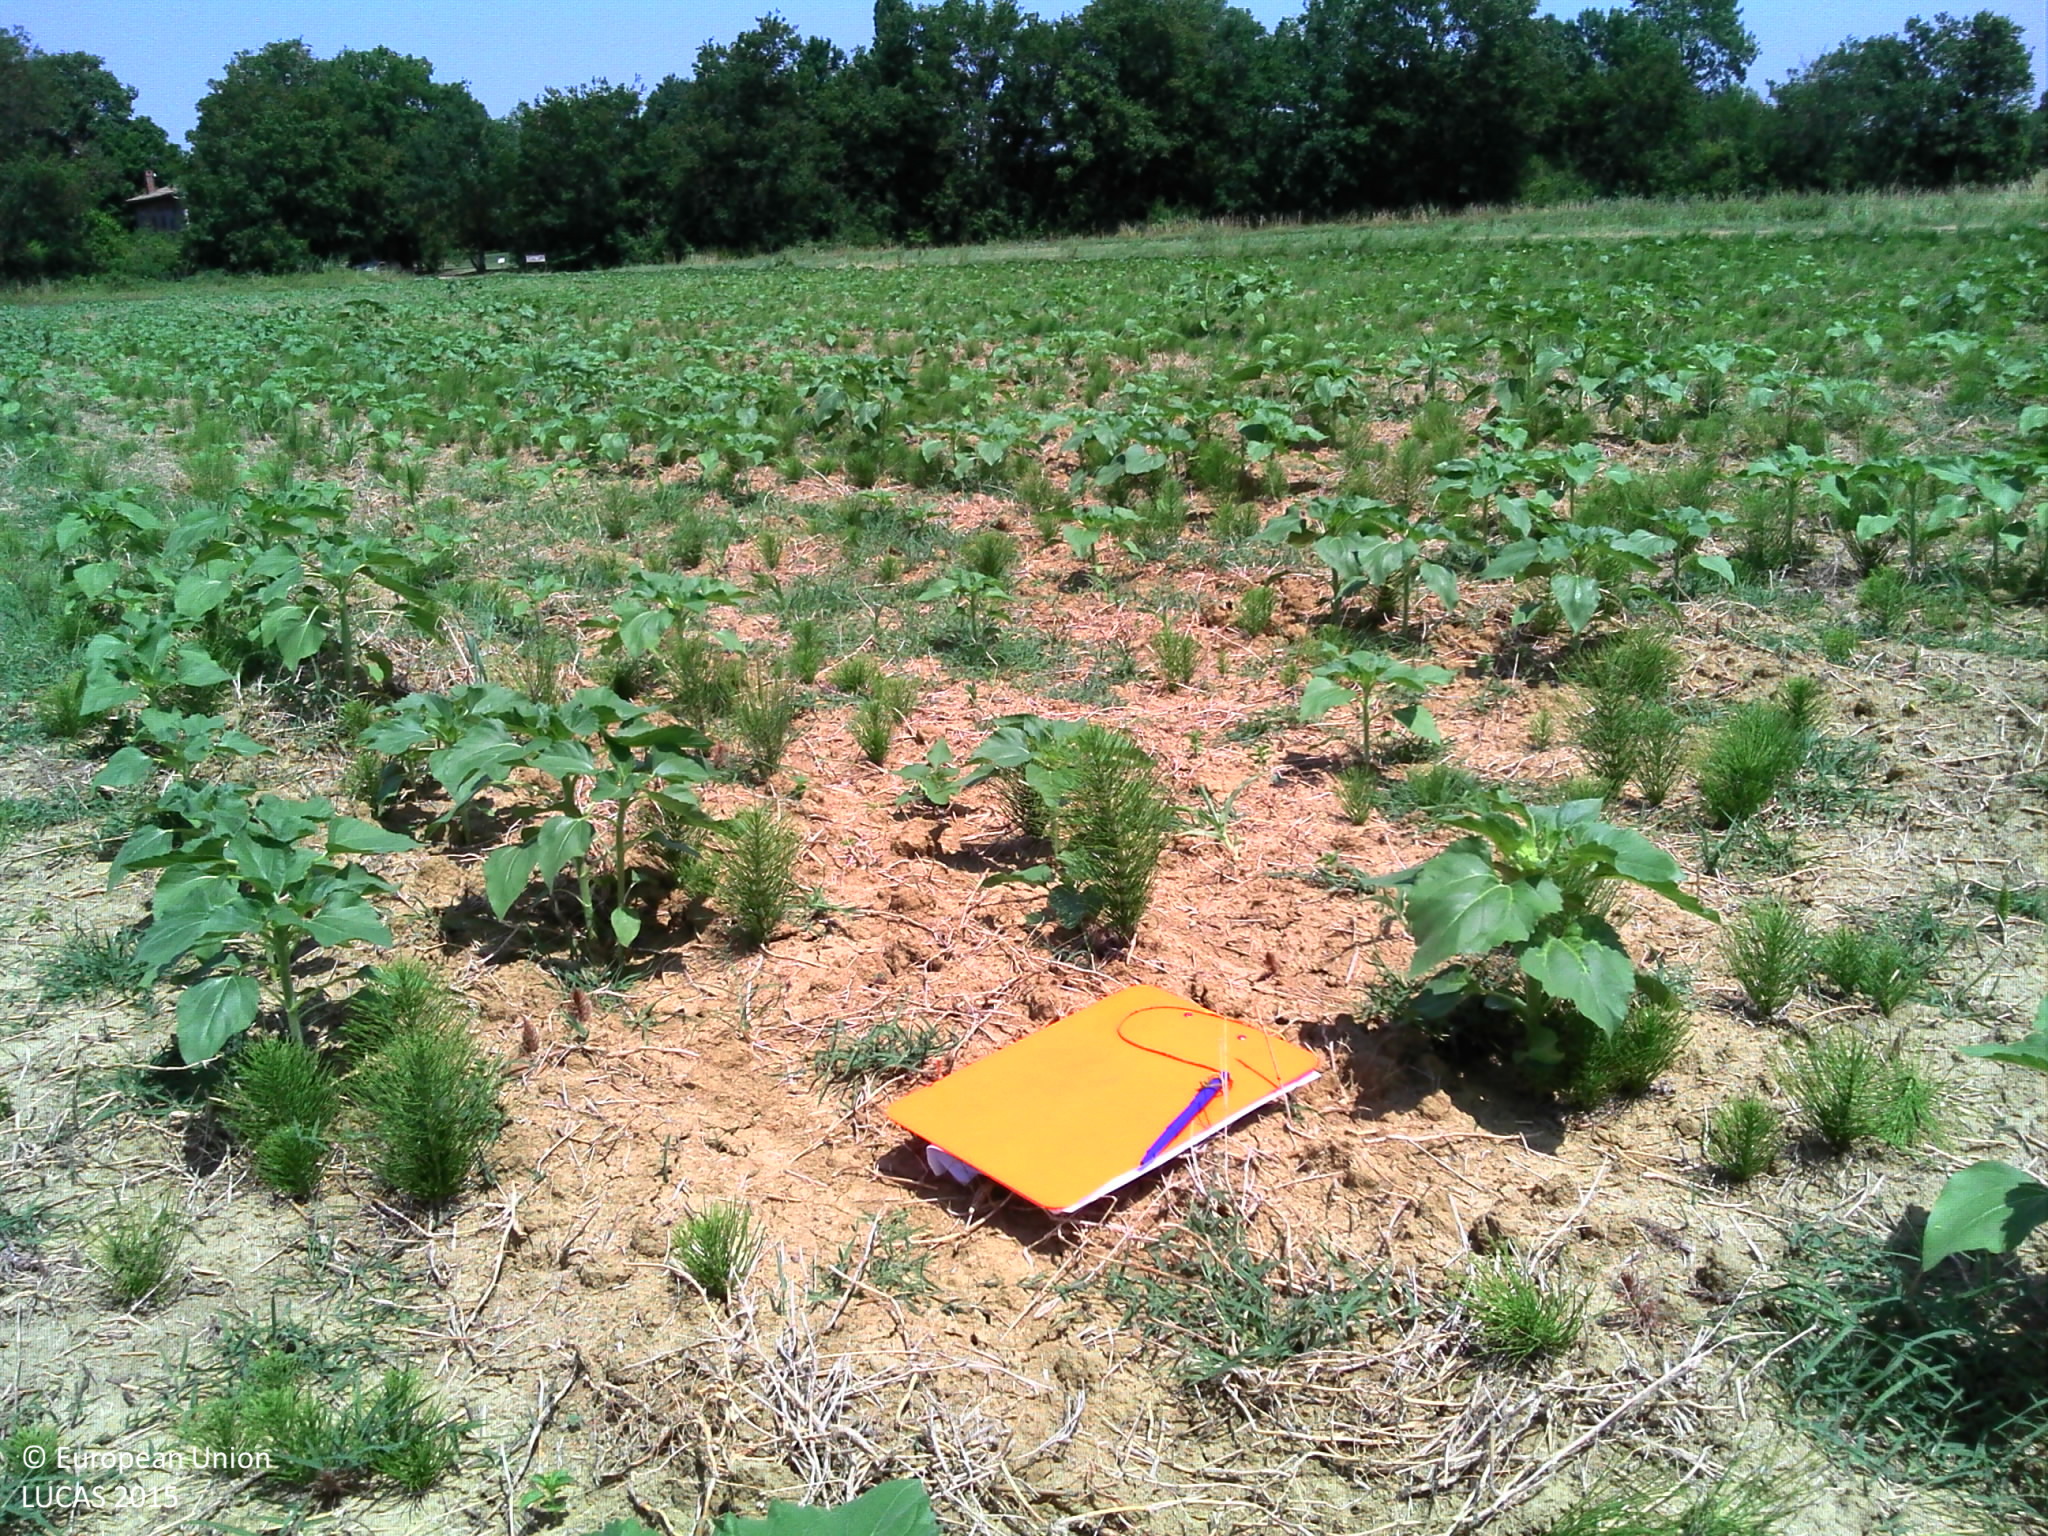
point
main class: Cropland
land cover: Sunflower
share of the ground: > 75 %
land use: Agriculture (excluding fallow land and kitchen gardens)
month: July
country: FR
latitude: 43.6040
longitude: 1.7406
